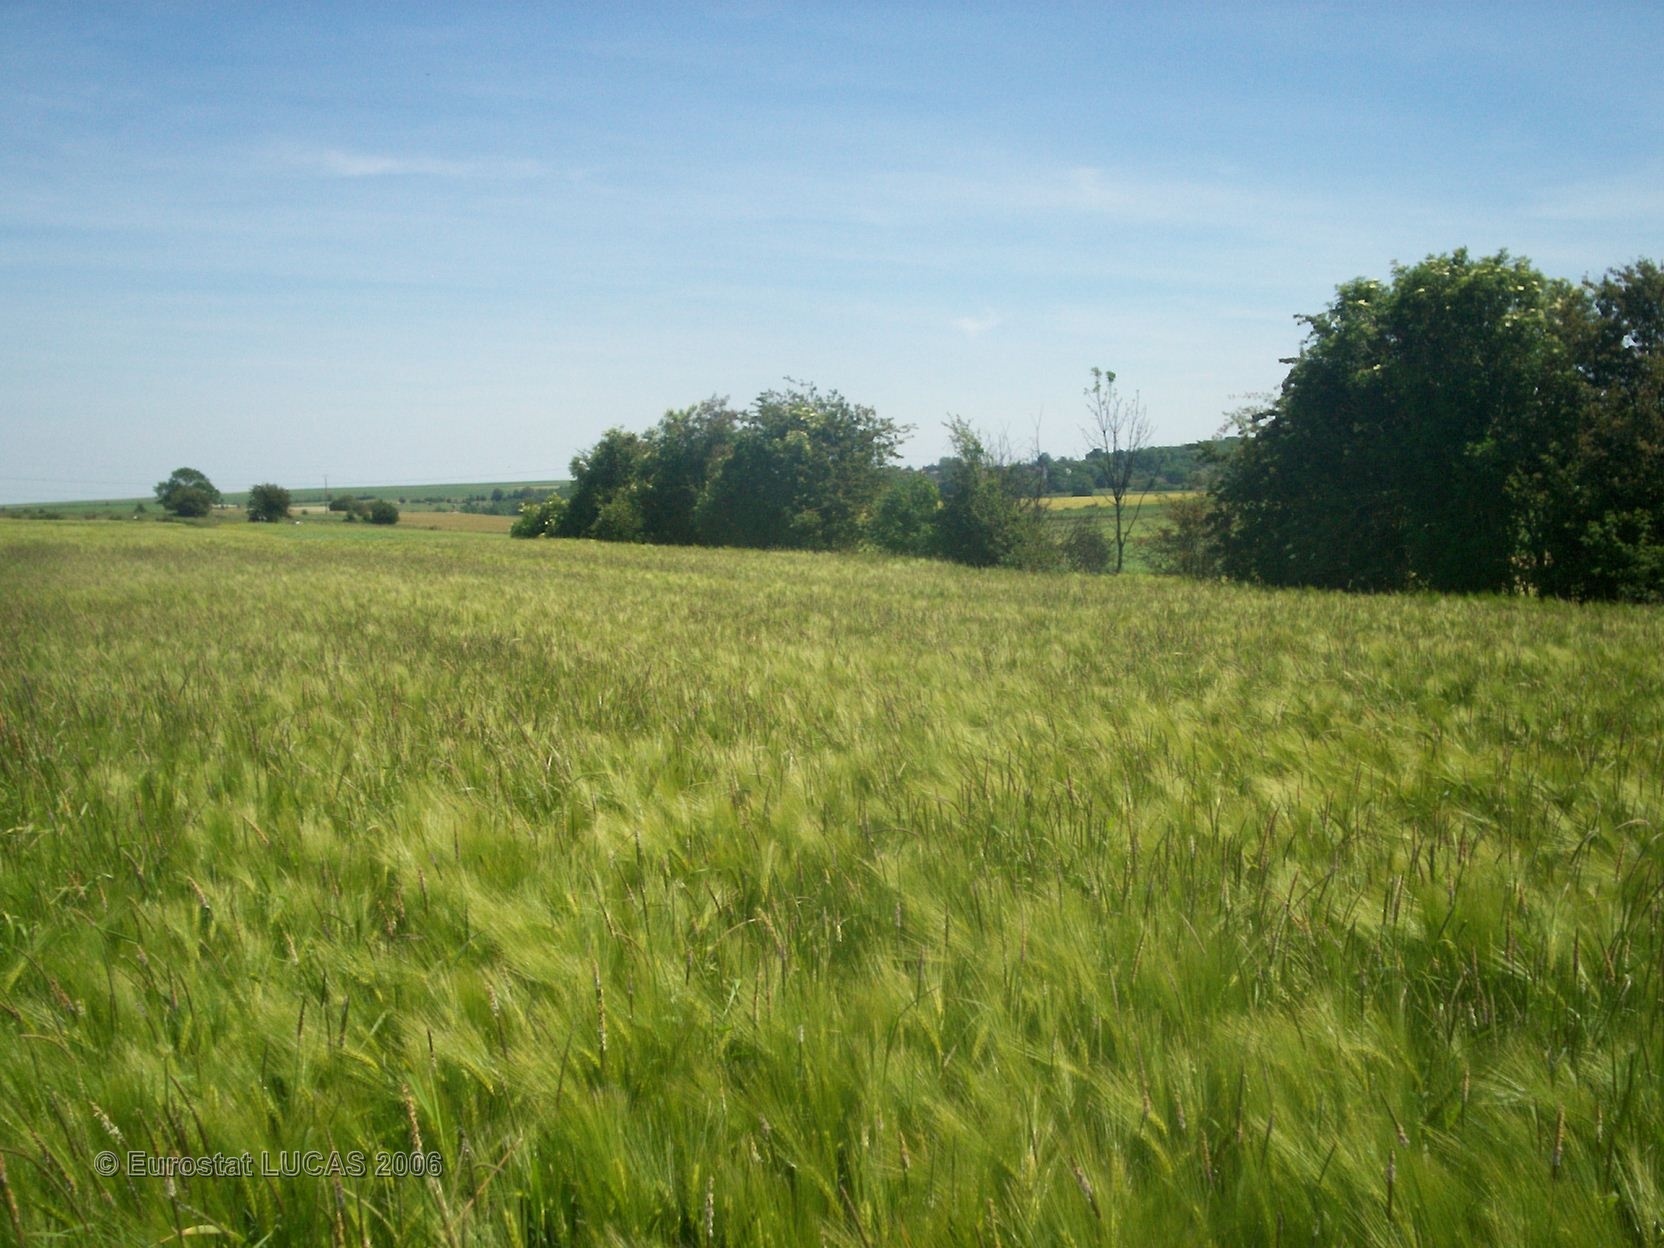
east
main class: Cropland
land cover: Barley
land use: Agriculture (excluding fallow land and kitchen gardens)
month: June
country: FR
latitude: 50.2486
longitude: 2.5693
